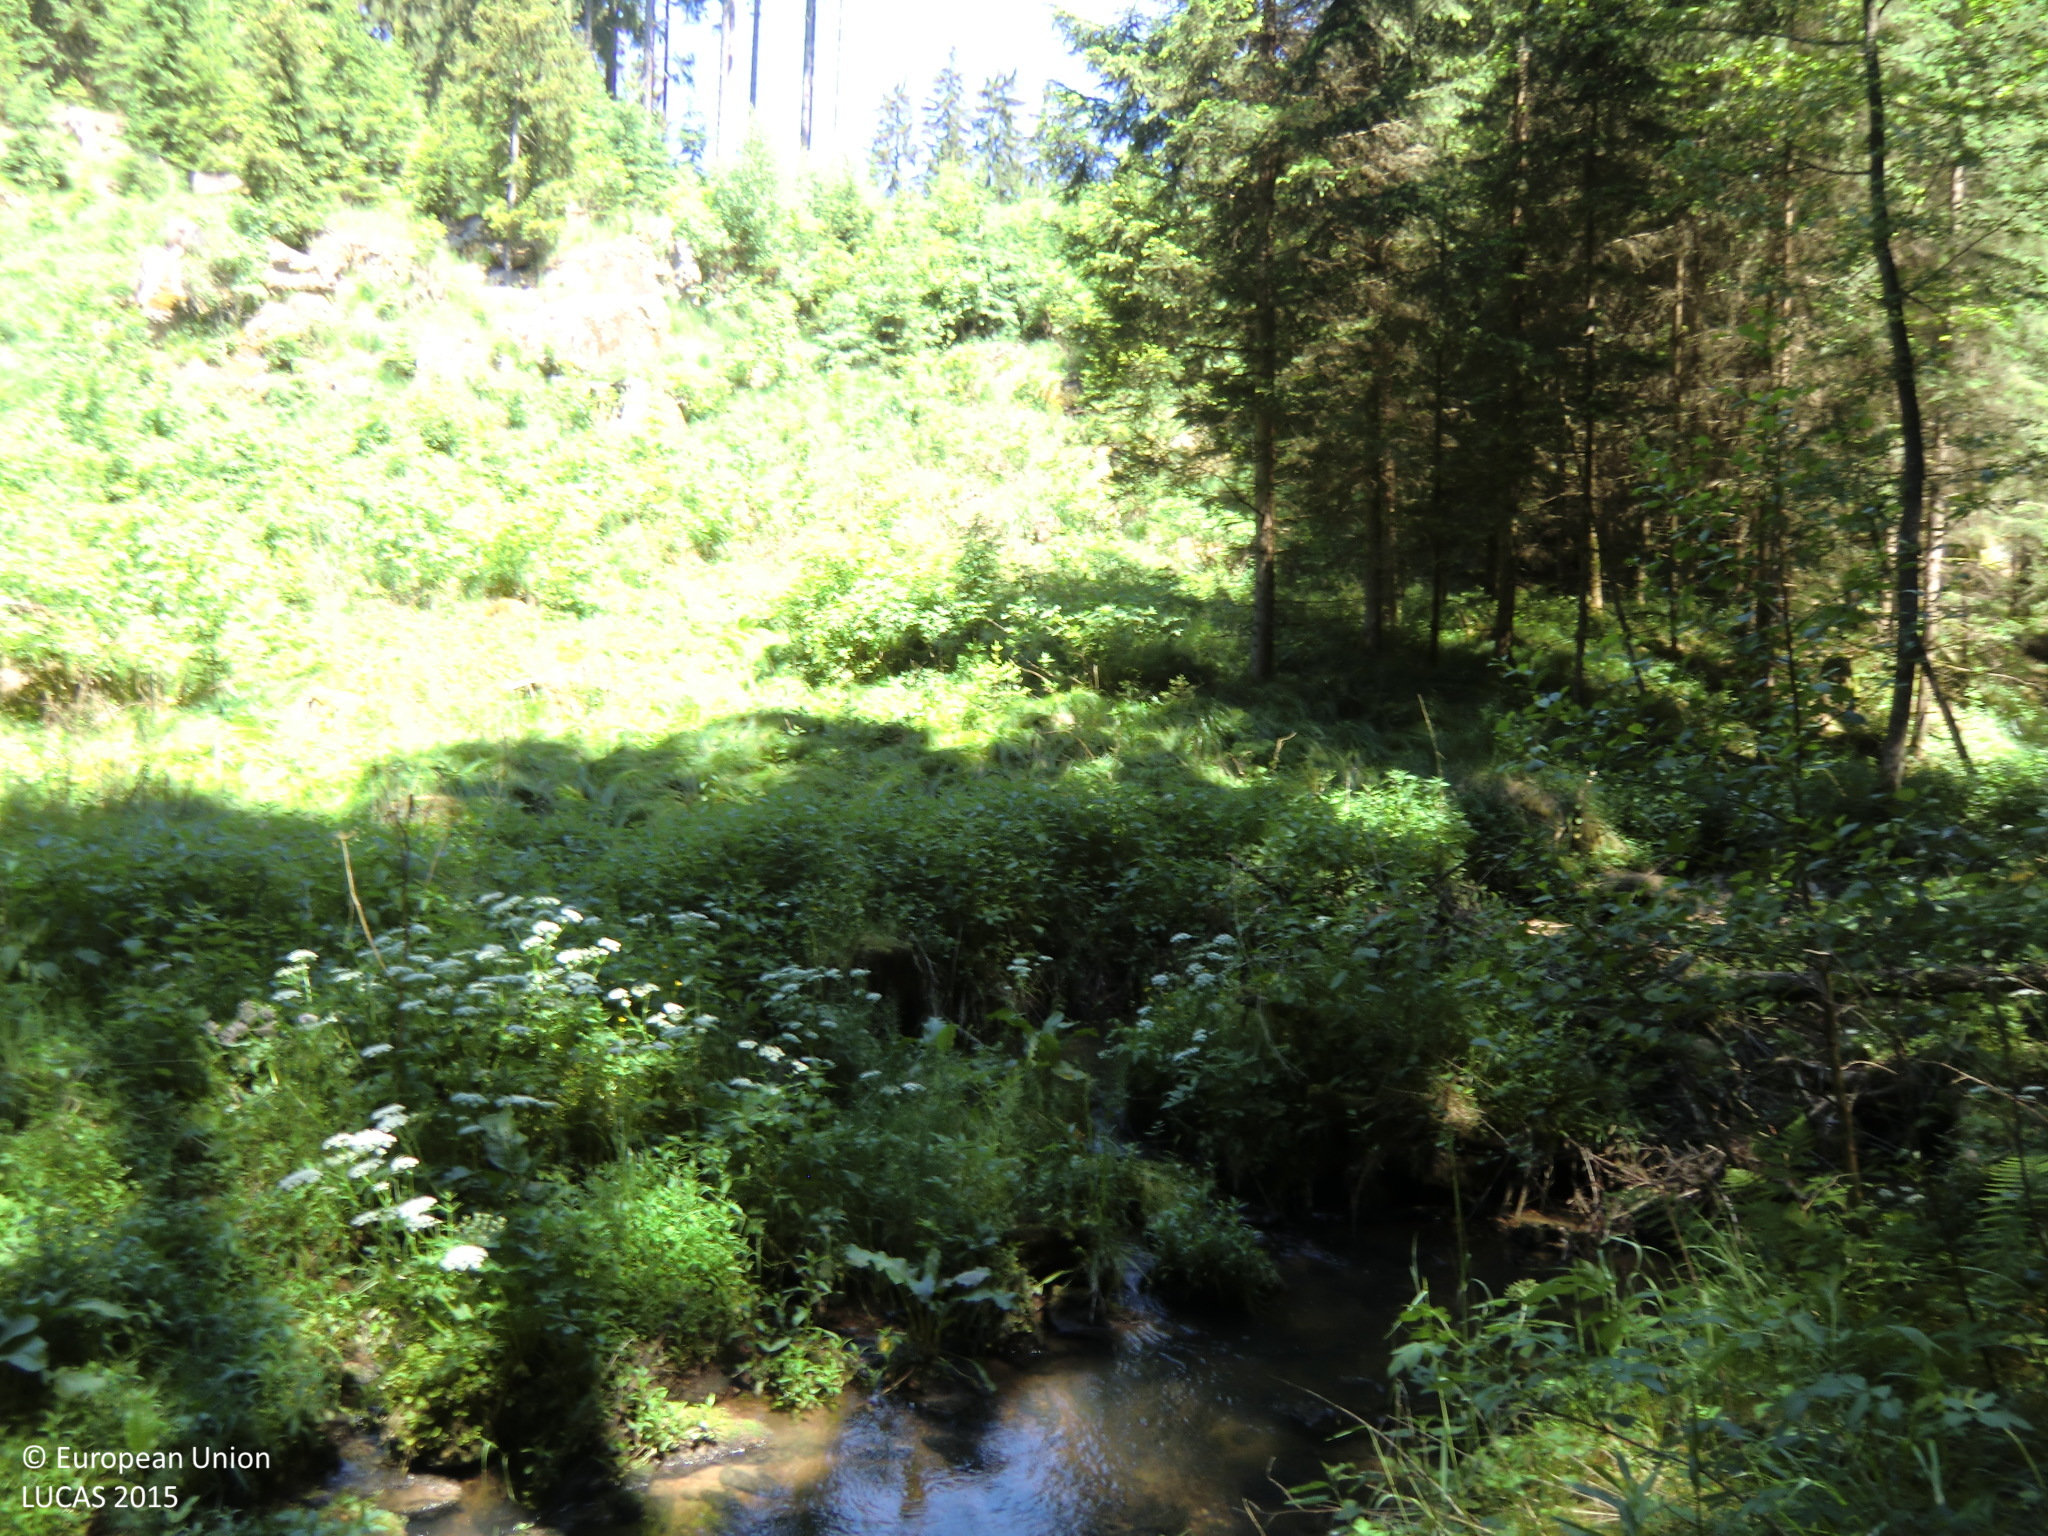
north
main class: Woodland
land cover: Spruce dominated coniferous woodland
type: hemiboreal forest and nemoral coniferous forest and mixed broadleaved-coniferous forest
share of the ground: > 75 %
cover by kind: coniferous forest trees 80 %, herbaceous plants 20 %
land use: Forestry
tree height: > 5 m
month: June
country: AT
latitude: 48.5680
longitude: 14.4050
